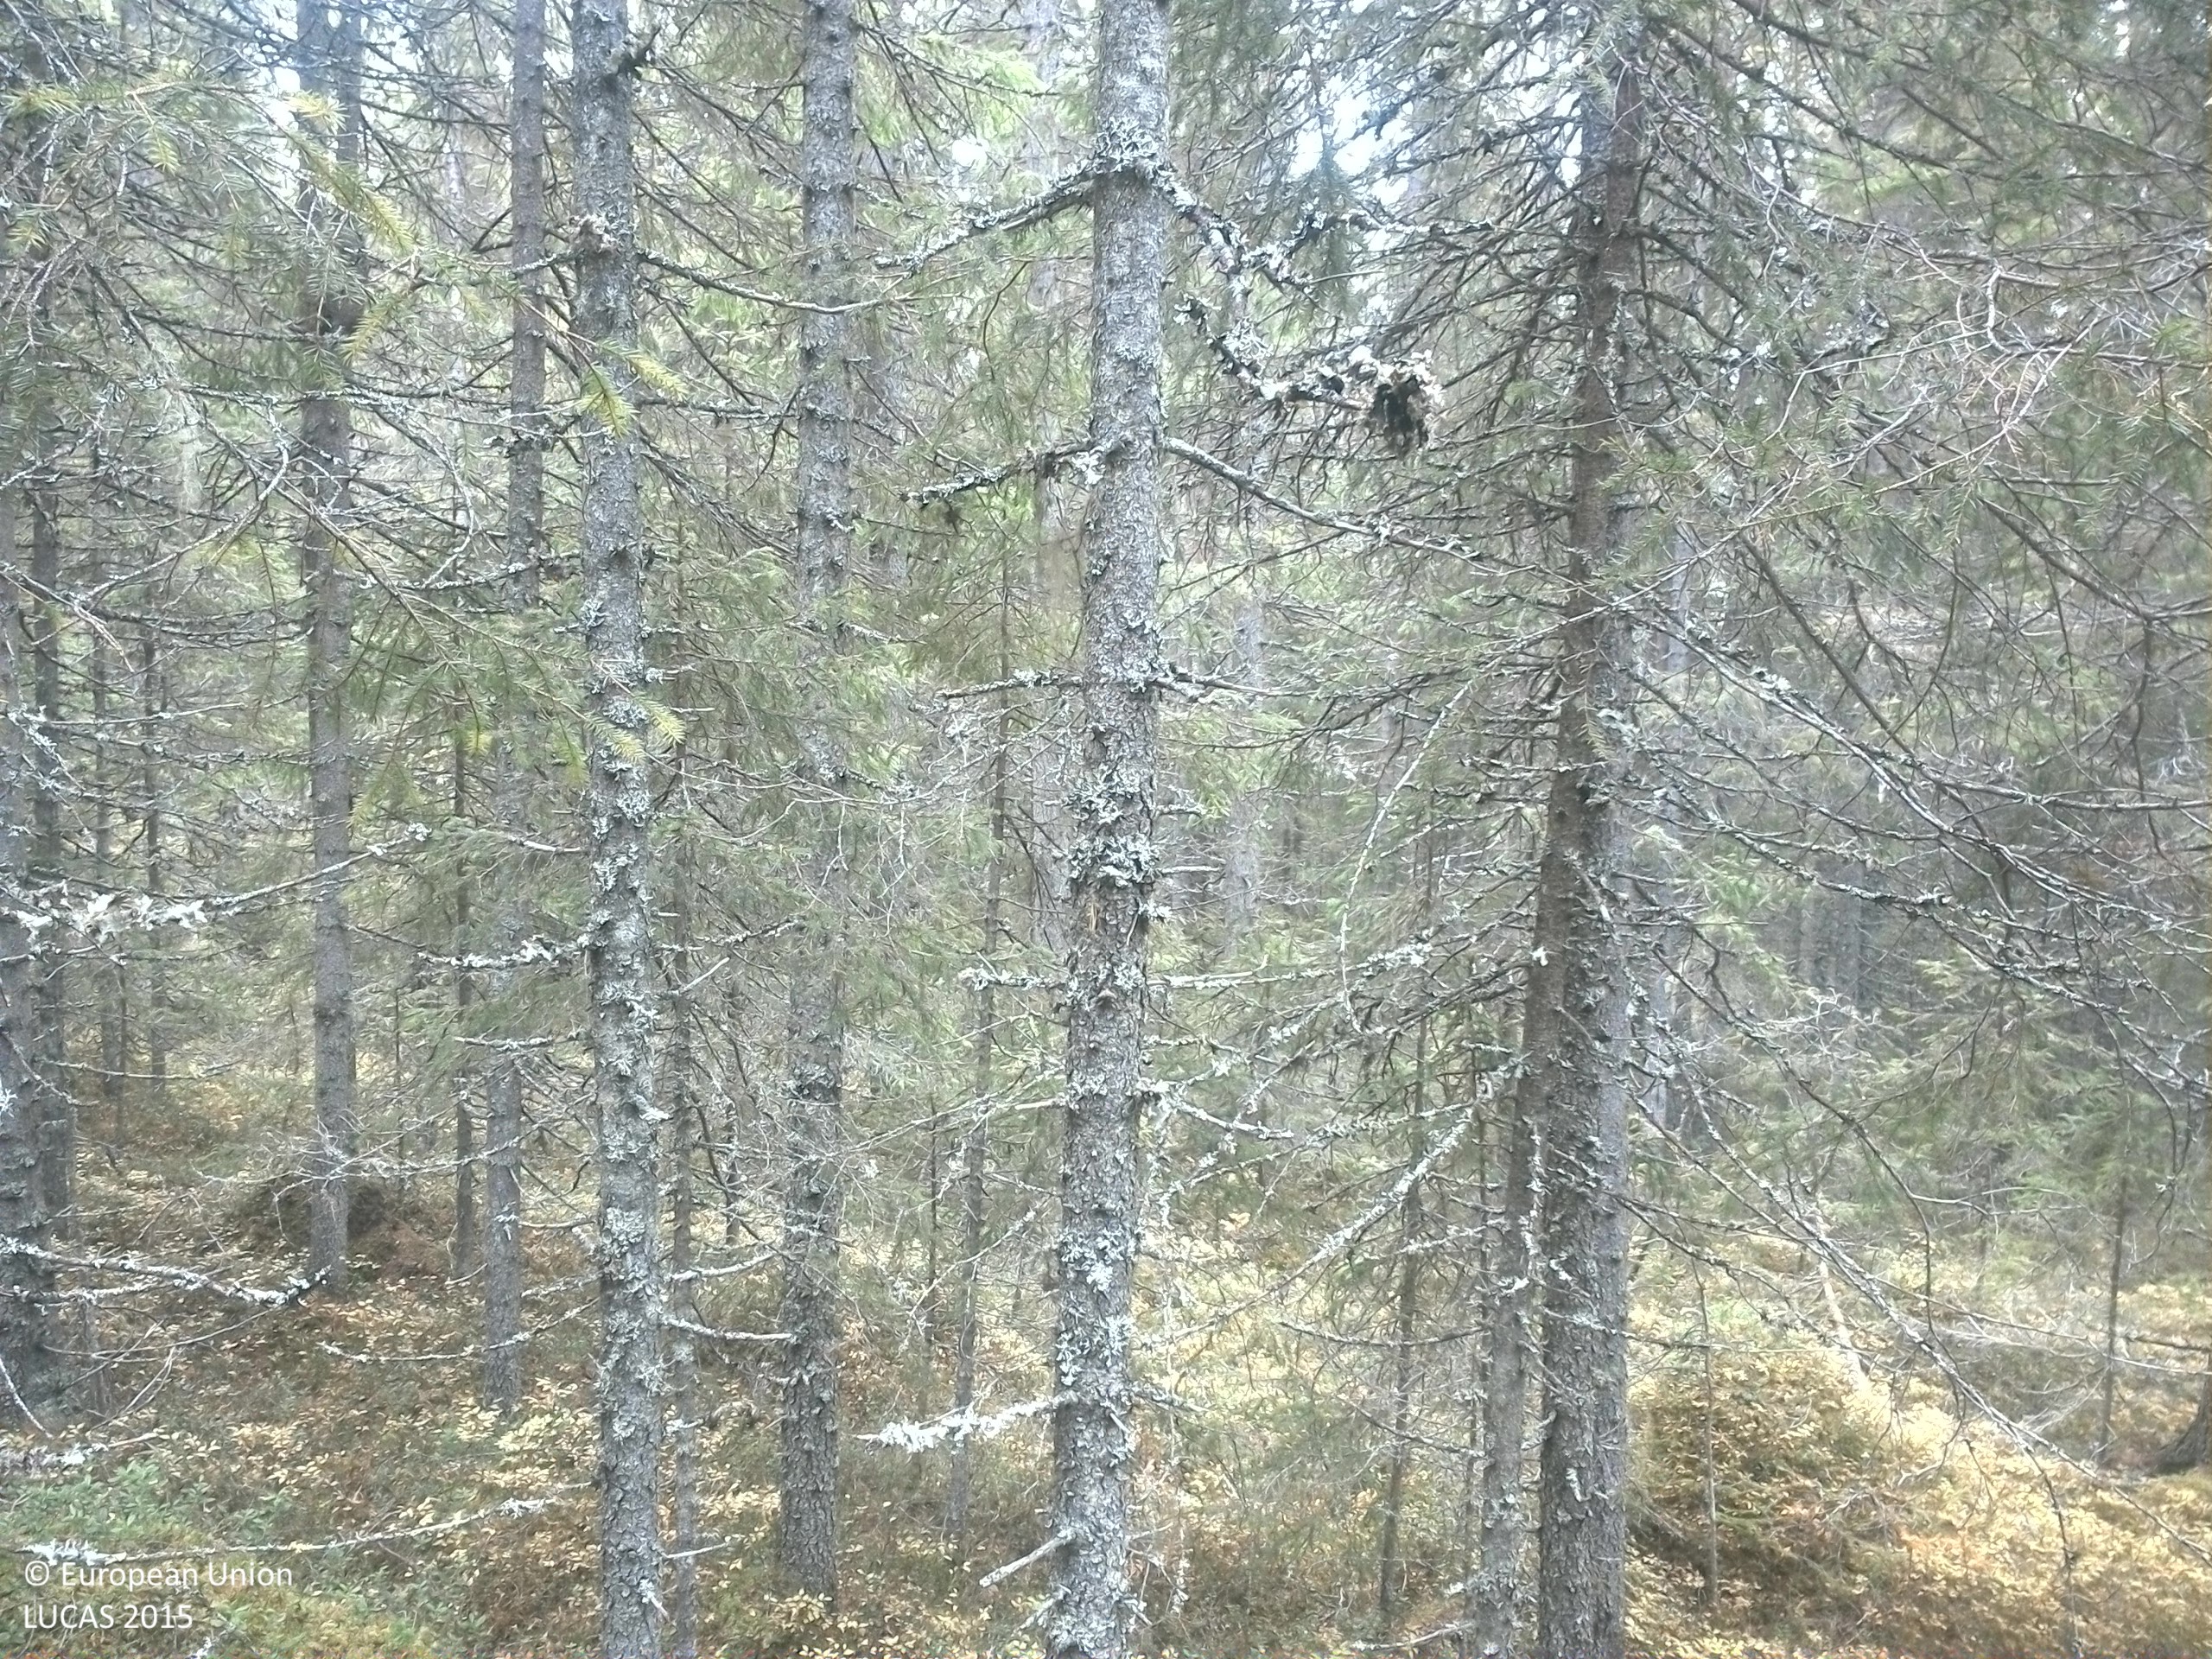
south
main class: Woodland
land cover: Spruce dominated coniferous woodland
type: boreal forest
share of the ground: 50 - 75 %
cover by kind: coniferous forest trees 65 %, shrubs 20 %, lichens and mosses 15 %
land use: Forestry
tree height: > 5 m
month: October
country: SE
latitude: 64.3424
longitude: 14.8375
